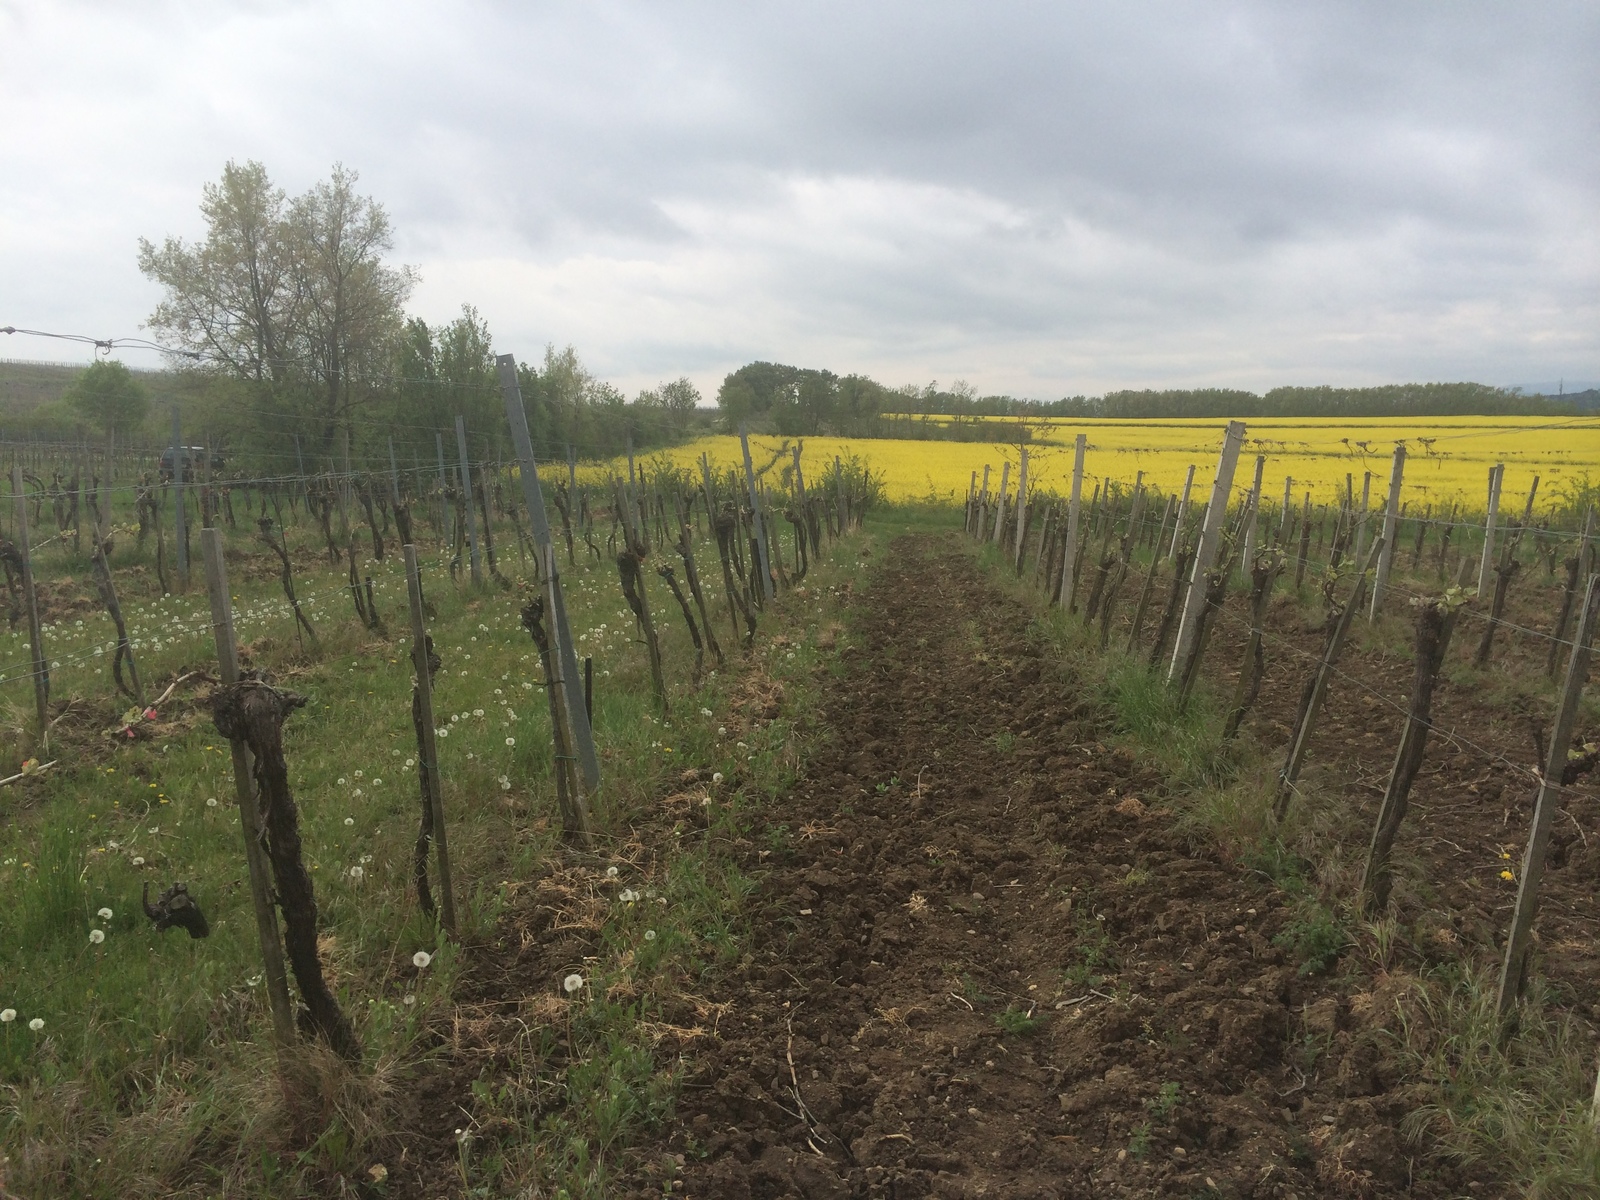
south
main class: Cropland
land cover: Vineyards
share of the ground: 25 - 50 %
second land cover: Spontaneously vegetated surfaces
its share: 50 - 75 %
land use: Agriculture (excluding fallow land and kitchen gardens)
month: May
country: AT
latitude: 47.9929
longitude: 16.2354
